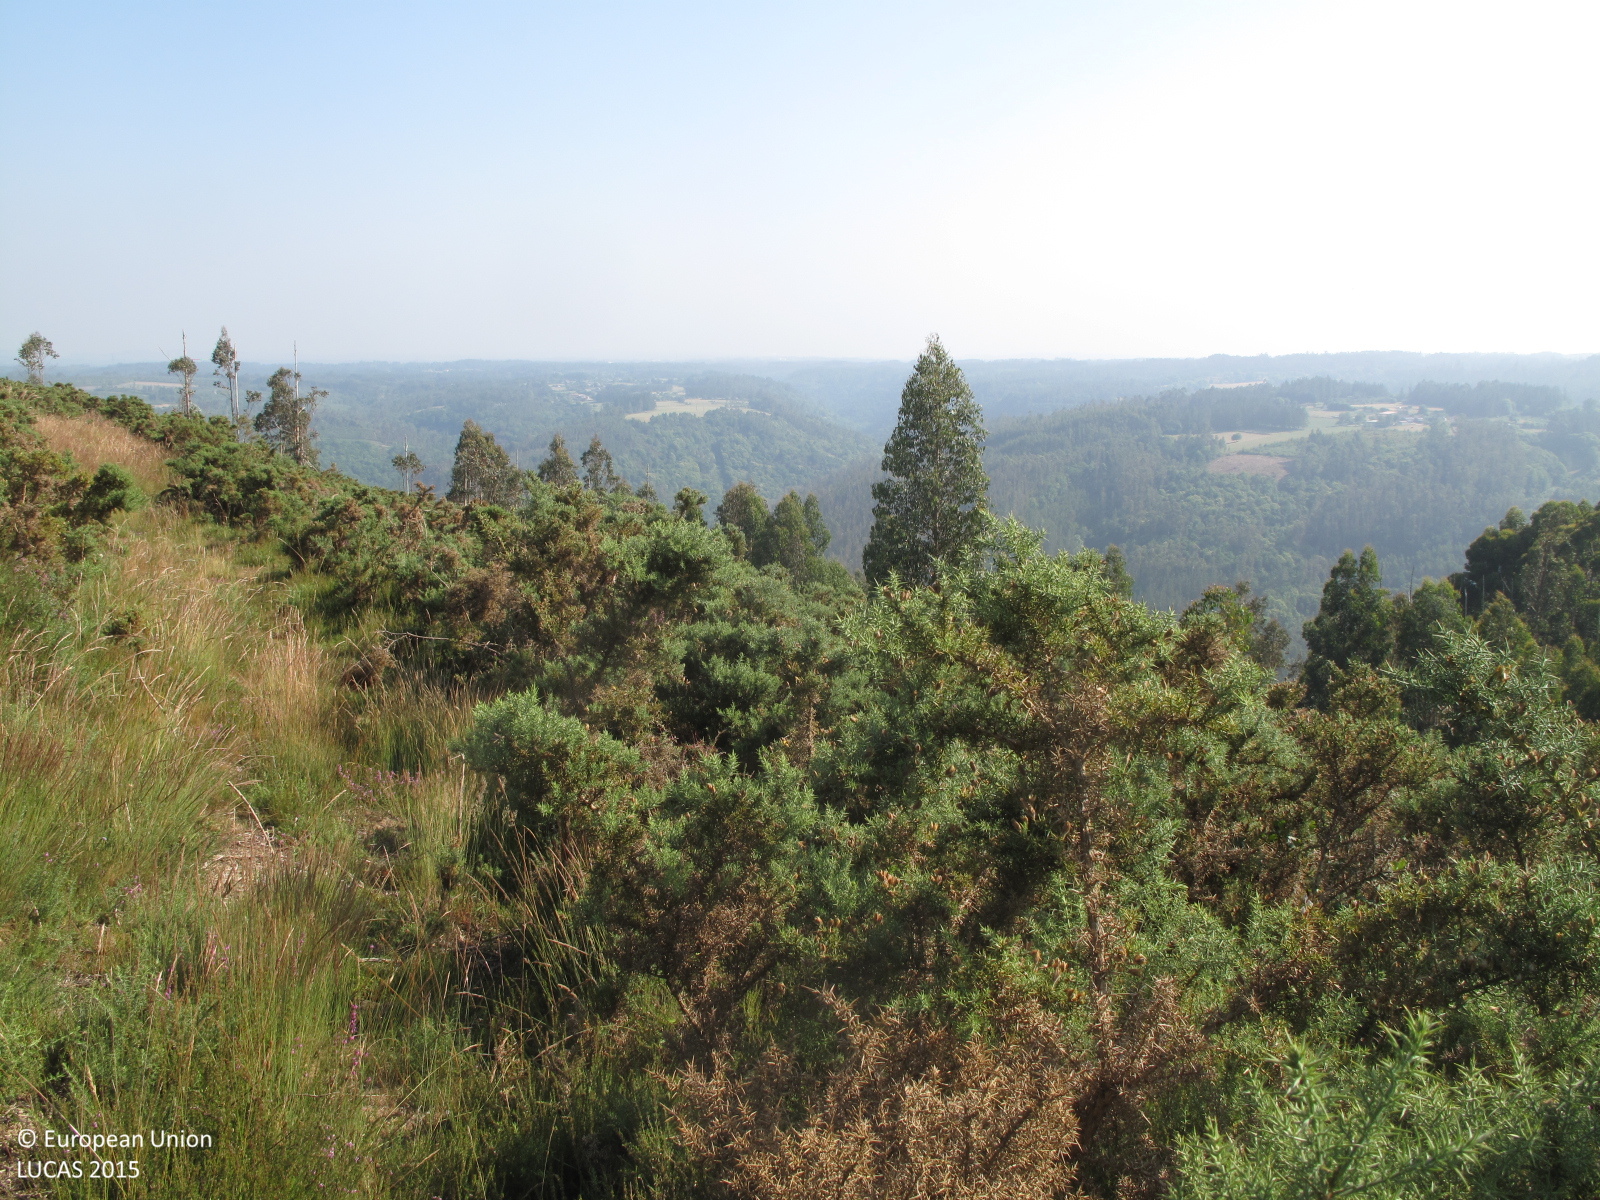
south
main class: Shrubland
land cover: Shrubland without tree cover
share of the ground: > 75 %
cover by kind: shrubs 90 %, herbaceous plants 10 %
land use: Semi-natural and natural areas not in use
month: June
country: ES
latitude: 43.2382
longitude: -8.0106
